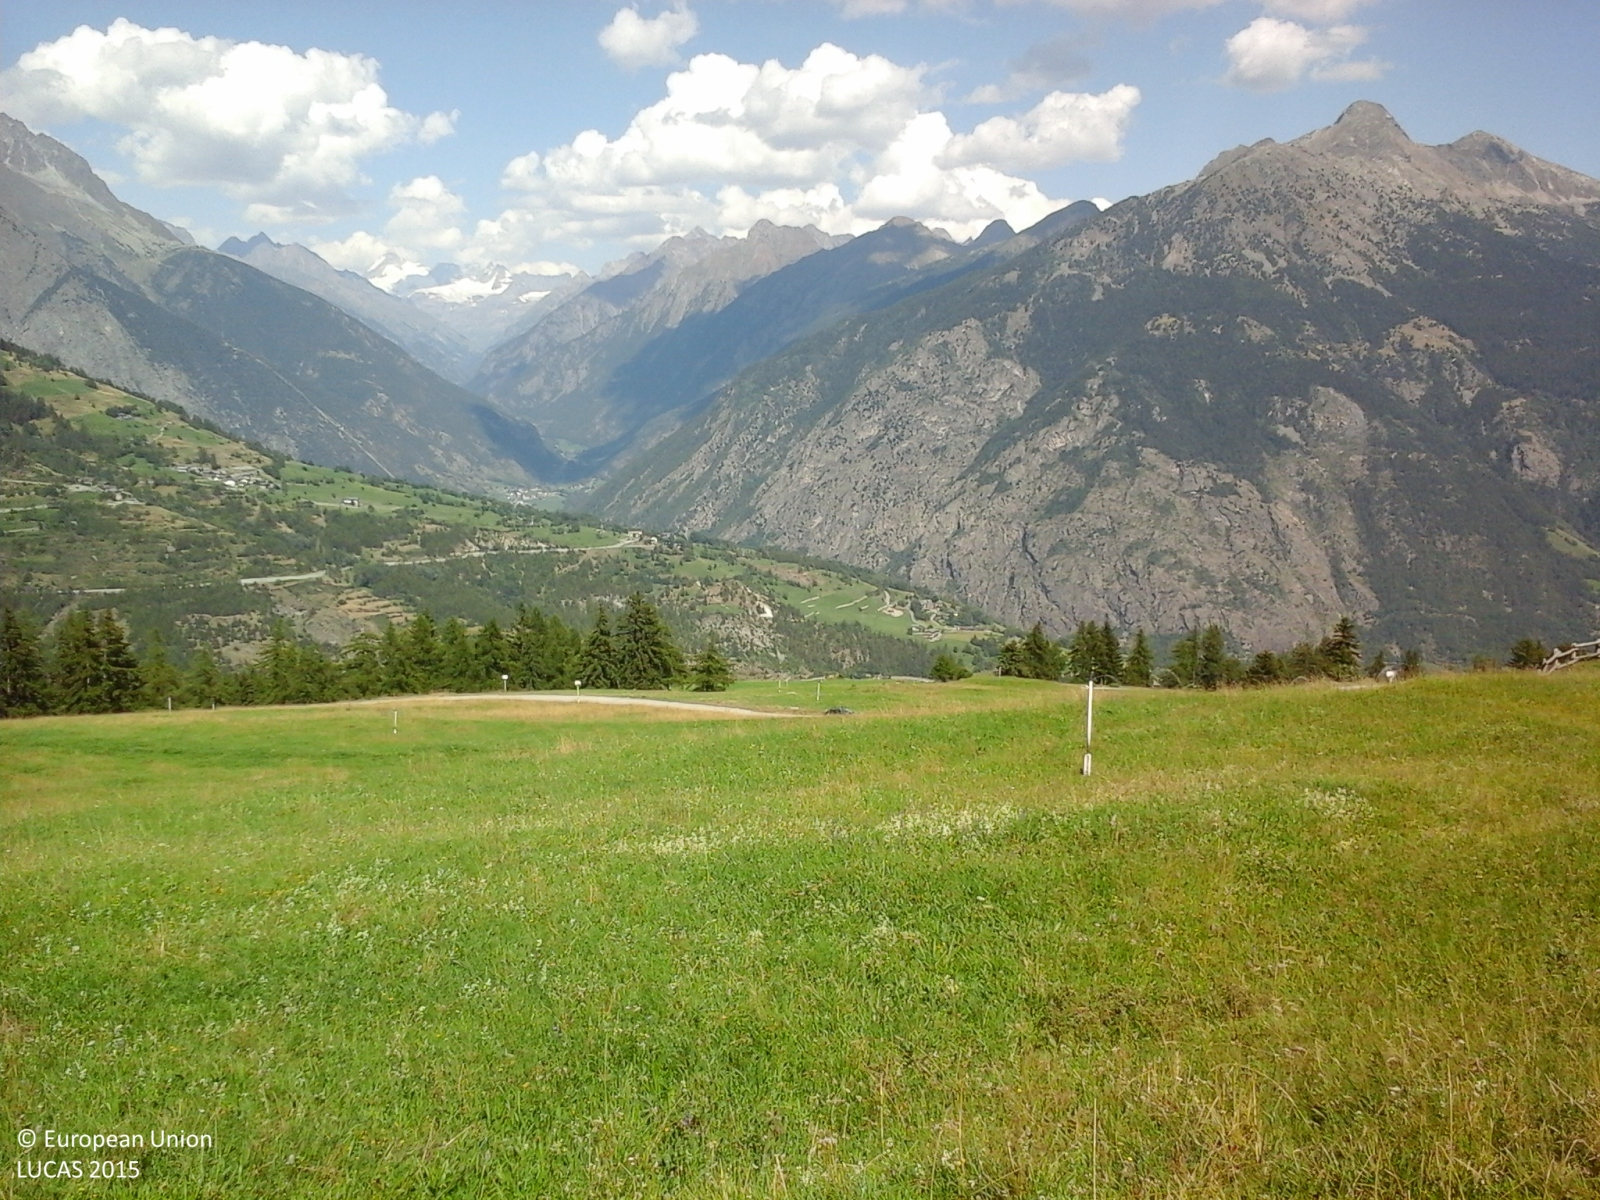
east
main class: Grassland
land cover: Grassland without tree/shrub cover
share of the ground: > 75 %
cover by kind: herbaceous plants 100 %
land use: Agriculture (excluding fallow land and kitchen gardens)
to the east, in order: Grassland without tree/shrub cover; Tracks; Grassland without tree/shrub cover; Tracks; Grassland without tree/shrub cover
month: August
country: IT
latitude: 45.7935
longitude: 7.2635
